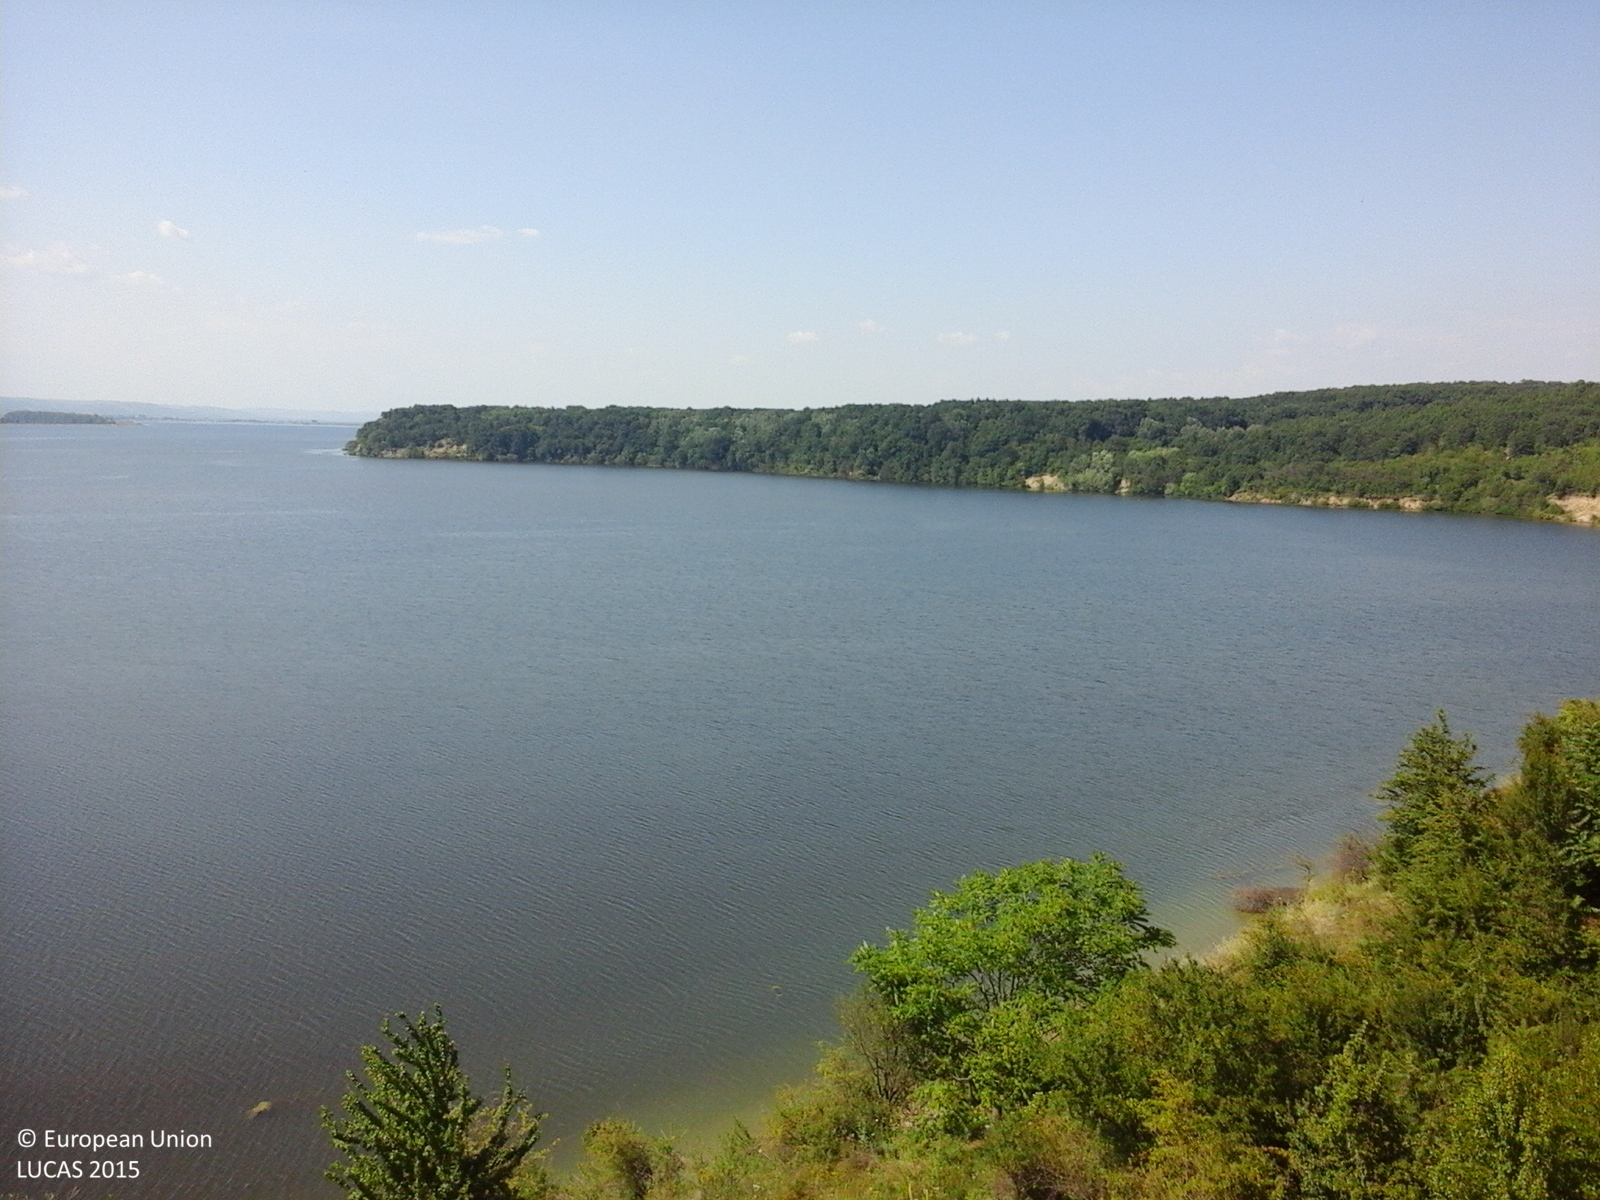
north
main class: Grassland
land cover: Grassland without tree/shrub cover
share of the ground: > 75 %
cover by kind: herbaceous plants 100 %
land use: Agriculture (excluding fallow land and kitchen gardens)
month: July
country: RO
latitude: 44.5747
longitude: 24.3366
